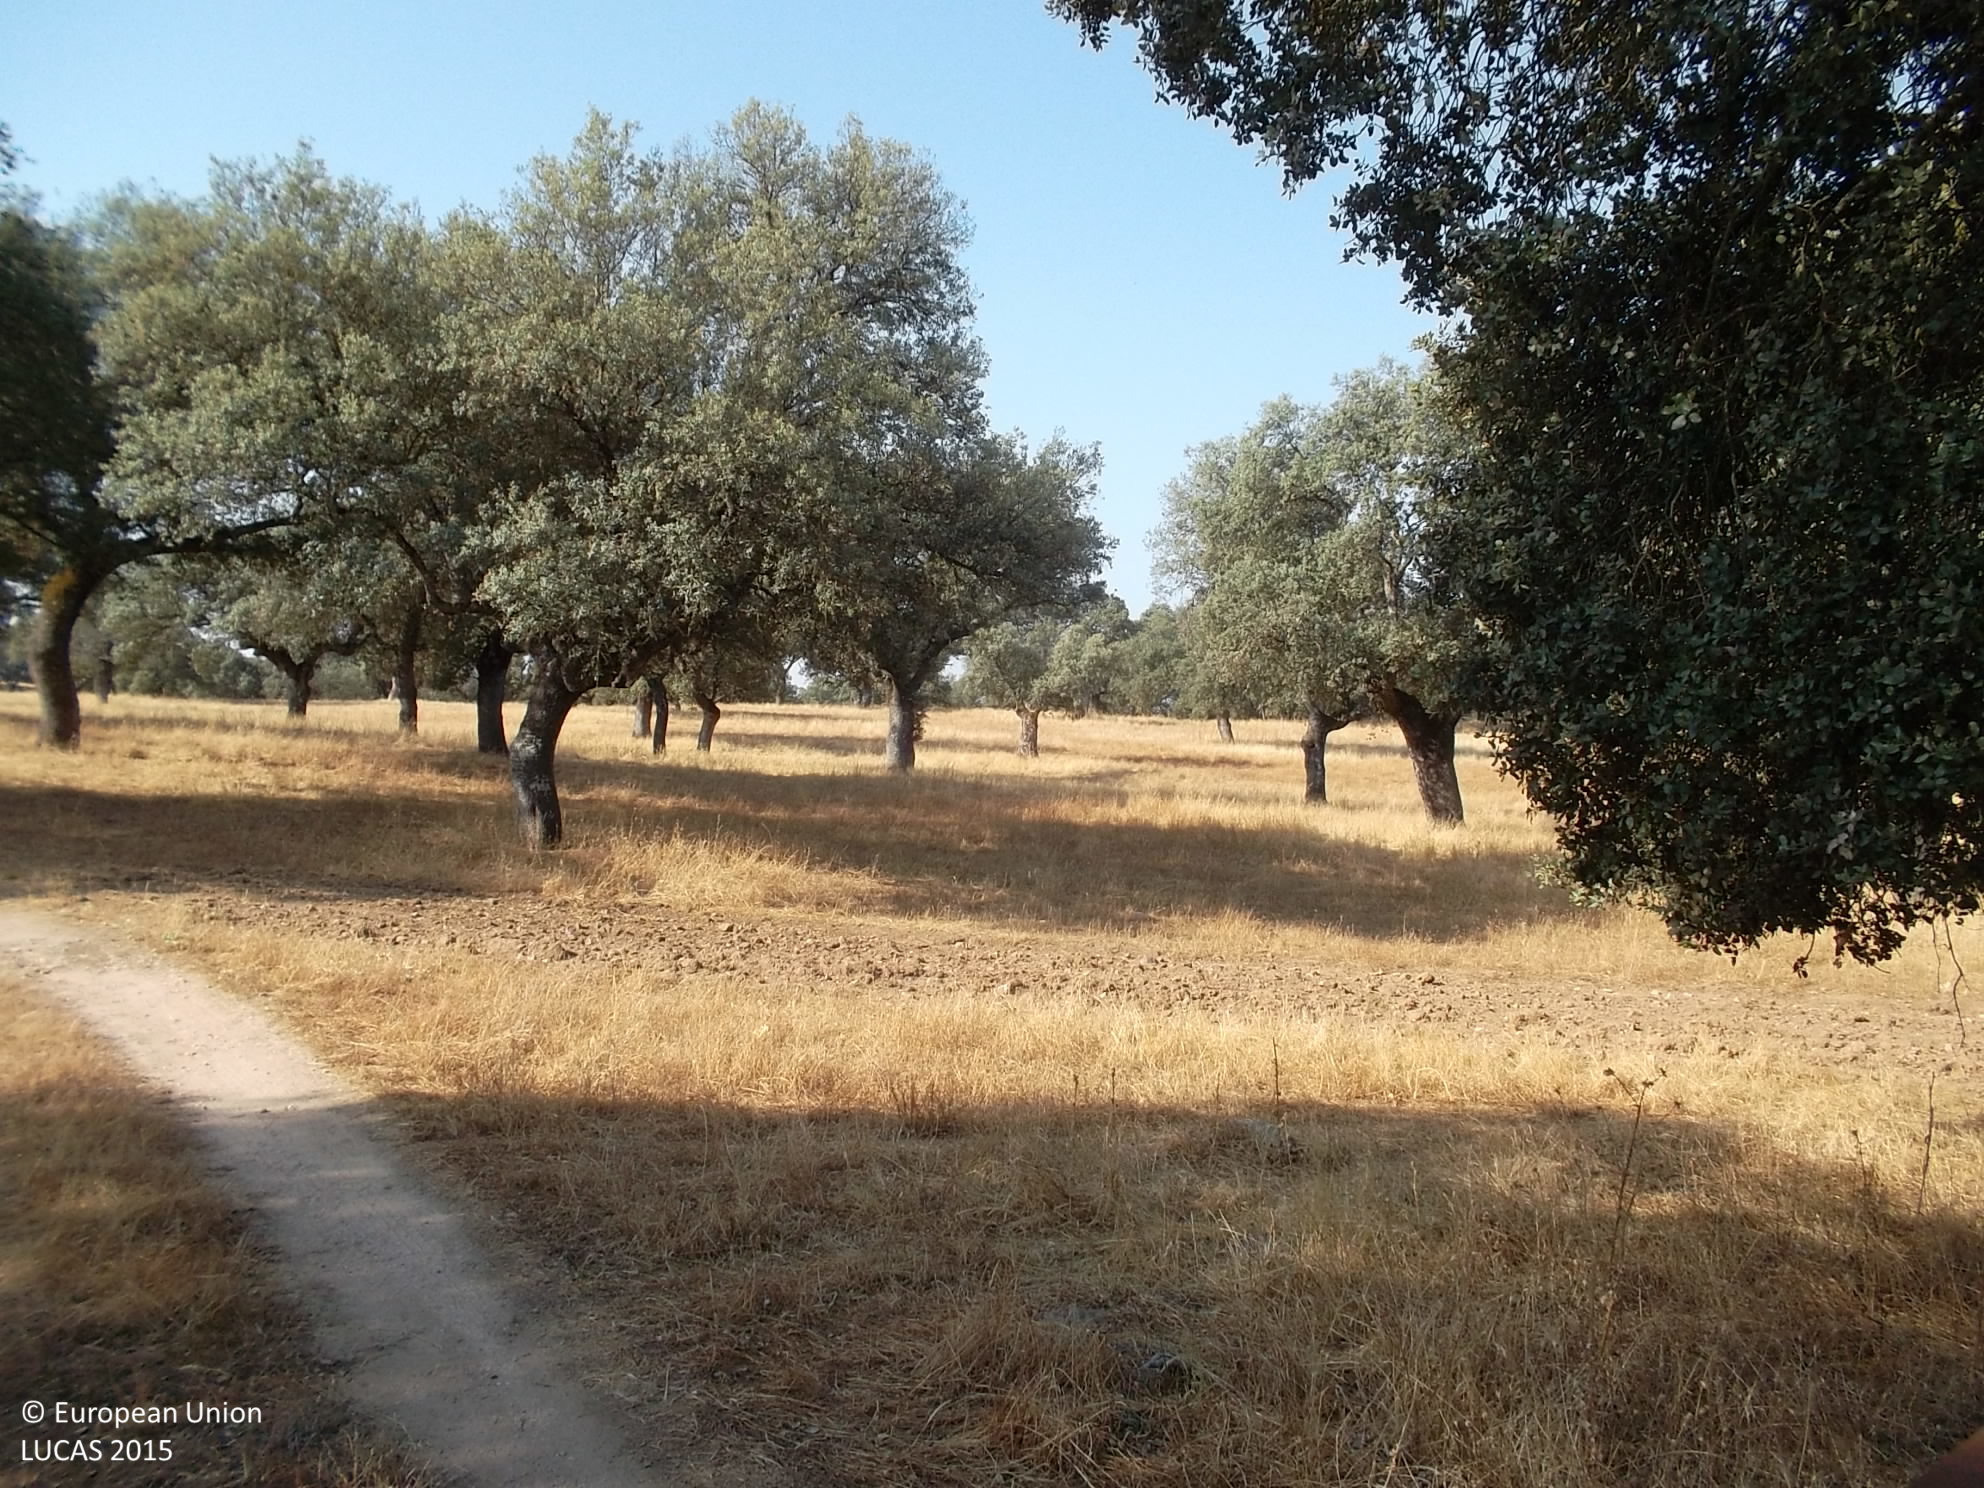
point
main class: Woodland
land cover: Broadleaved woodland
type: broadleaved evergreen forest
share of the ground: 25 - 50 %
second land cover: Grassland without tree/shrub cover
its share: > 75 %
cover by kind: herbaceous plants 70 %, broadleaved forest trees 30 %
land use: Forestry
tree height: > 5 m
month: July
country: ES
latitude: 38.2883
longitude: -4.7114
